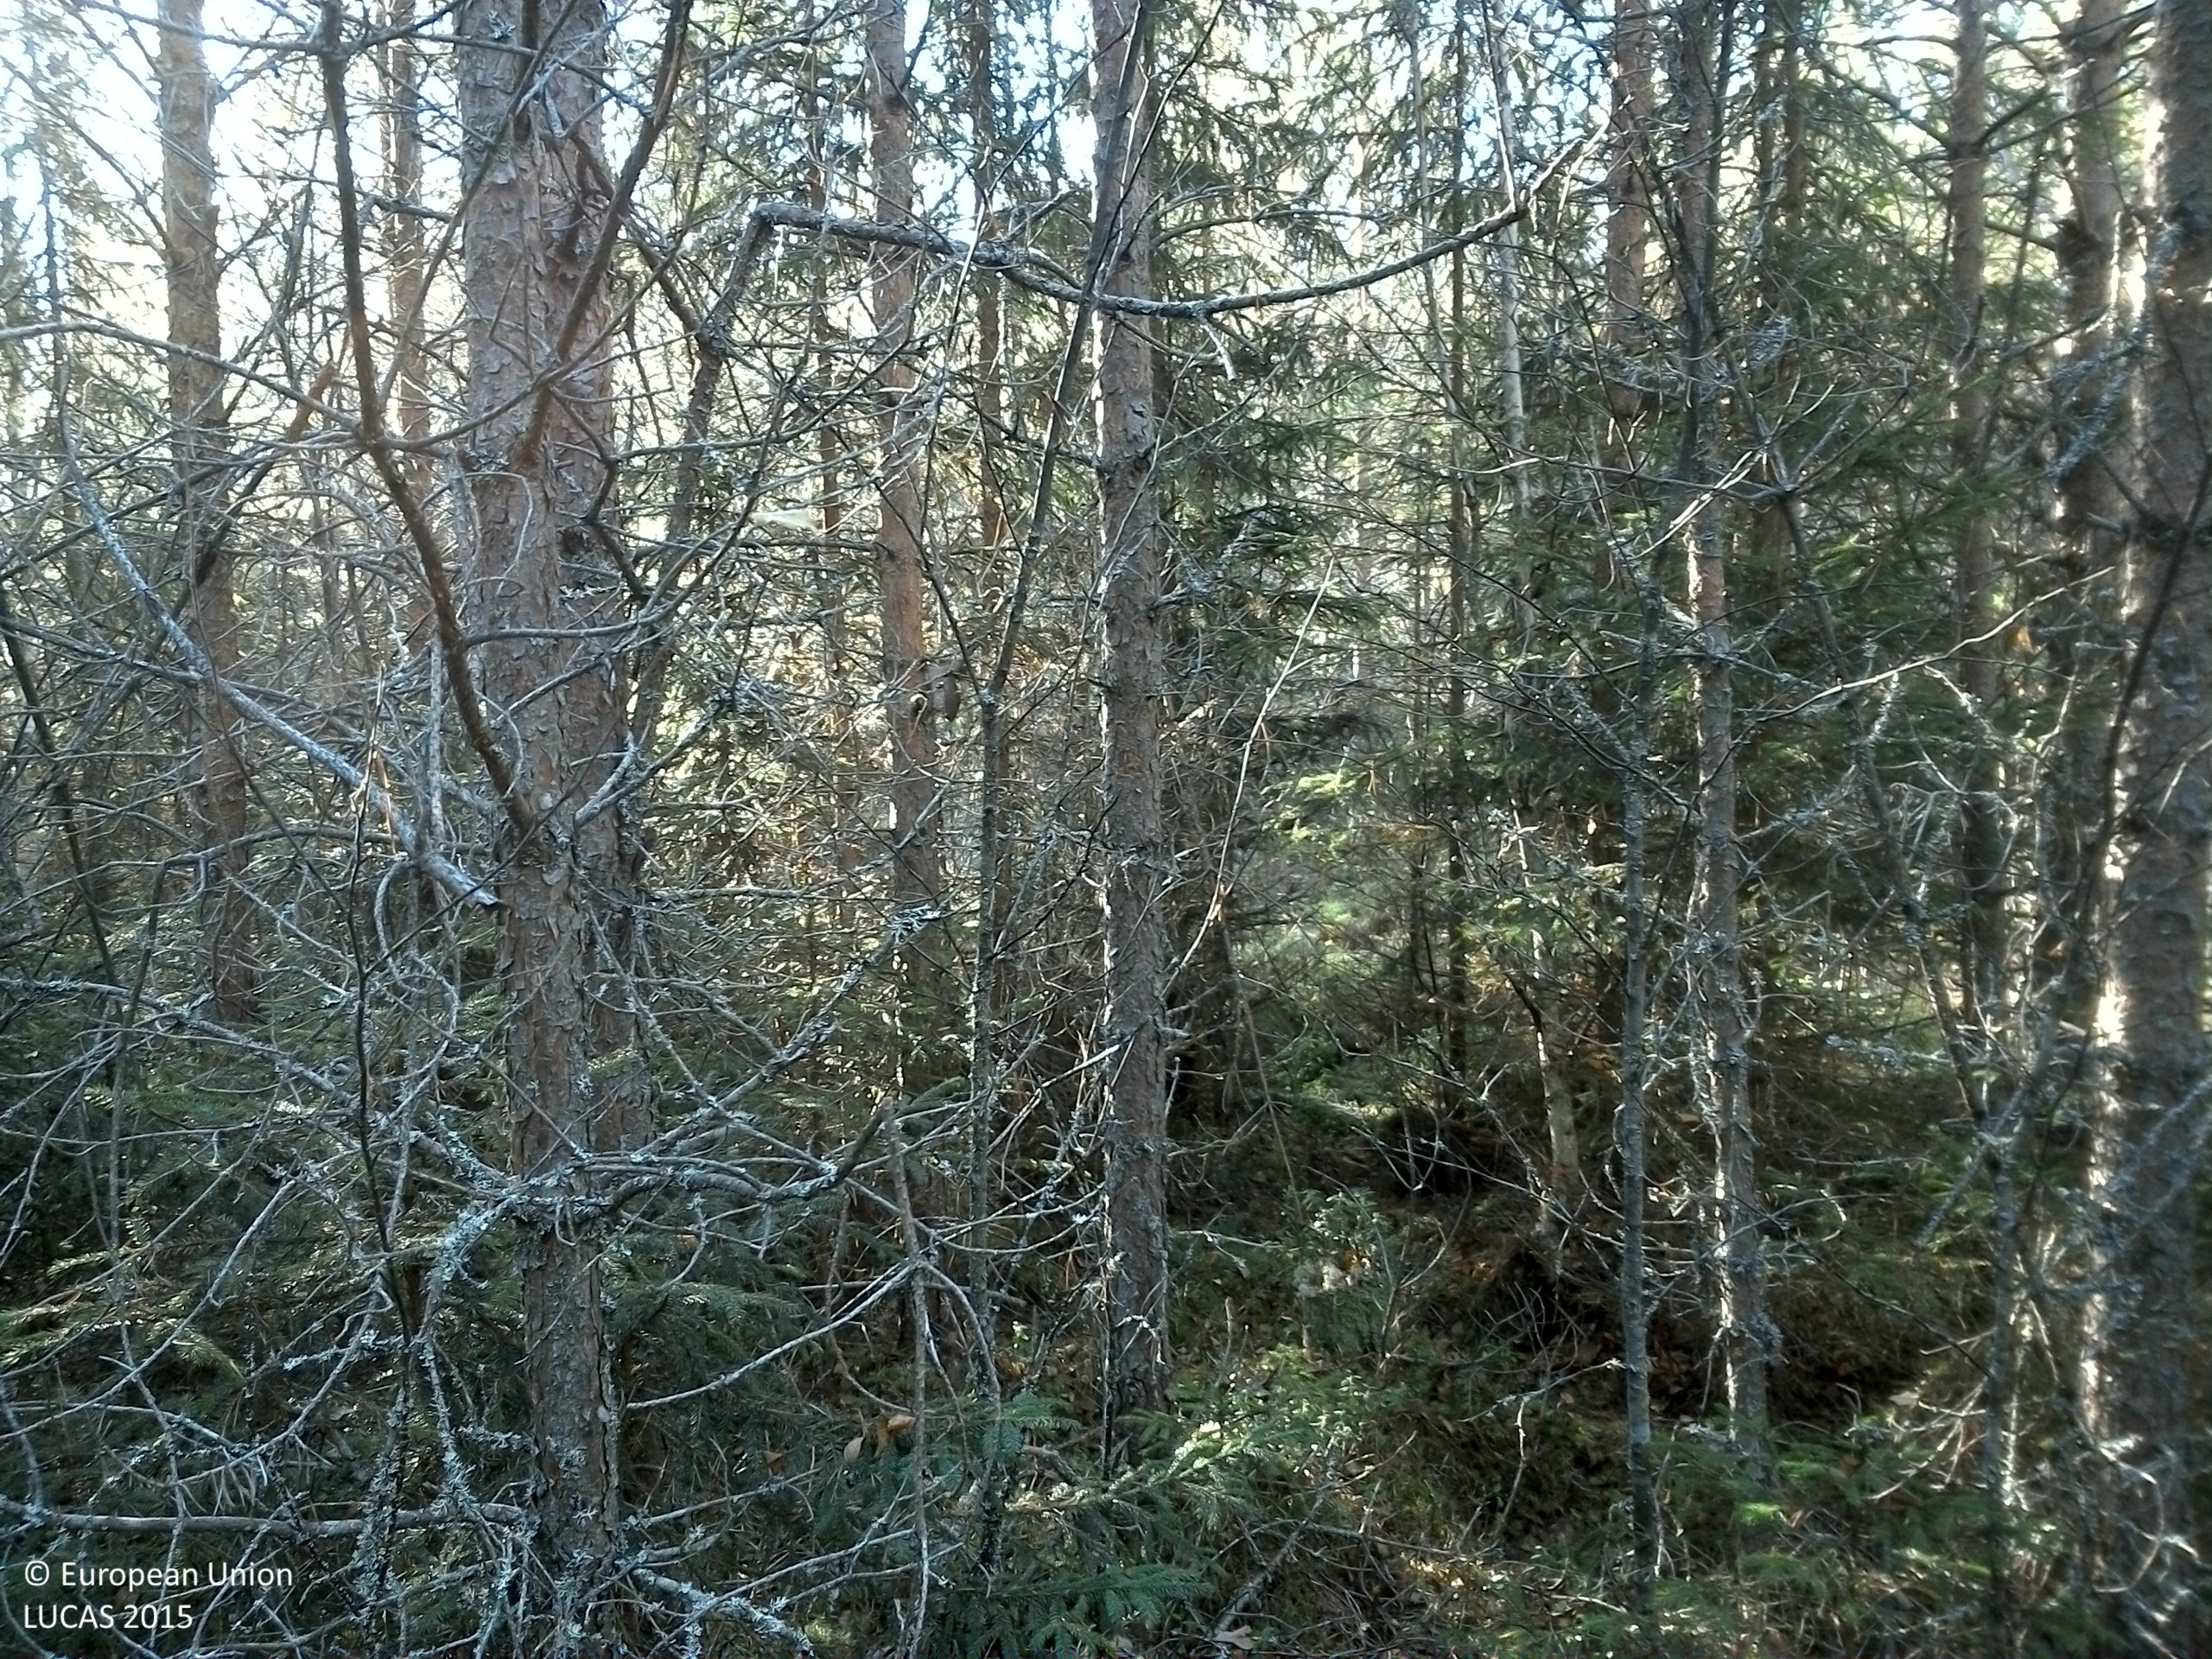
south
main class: Woodland
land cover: Pine dominated coniferous woodland
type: boreal forest
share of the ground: > 75 %
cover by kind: coniferous forest trees 75 %, shrubs 15 %, lichens and mosses 10 %
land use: Forestry
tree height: > 5 m
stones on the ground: < 10 %
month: October
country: SE
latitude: 61.1269
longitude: 14.2381
